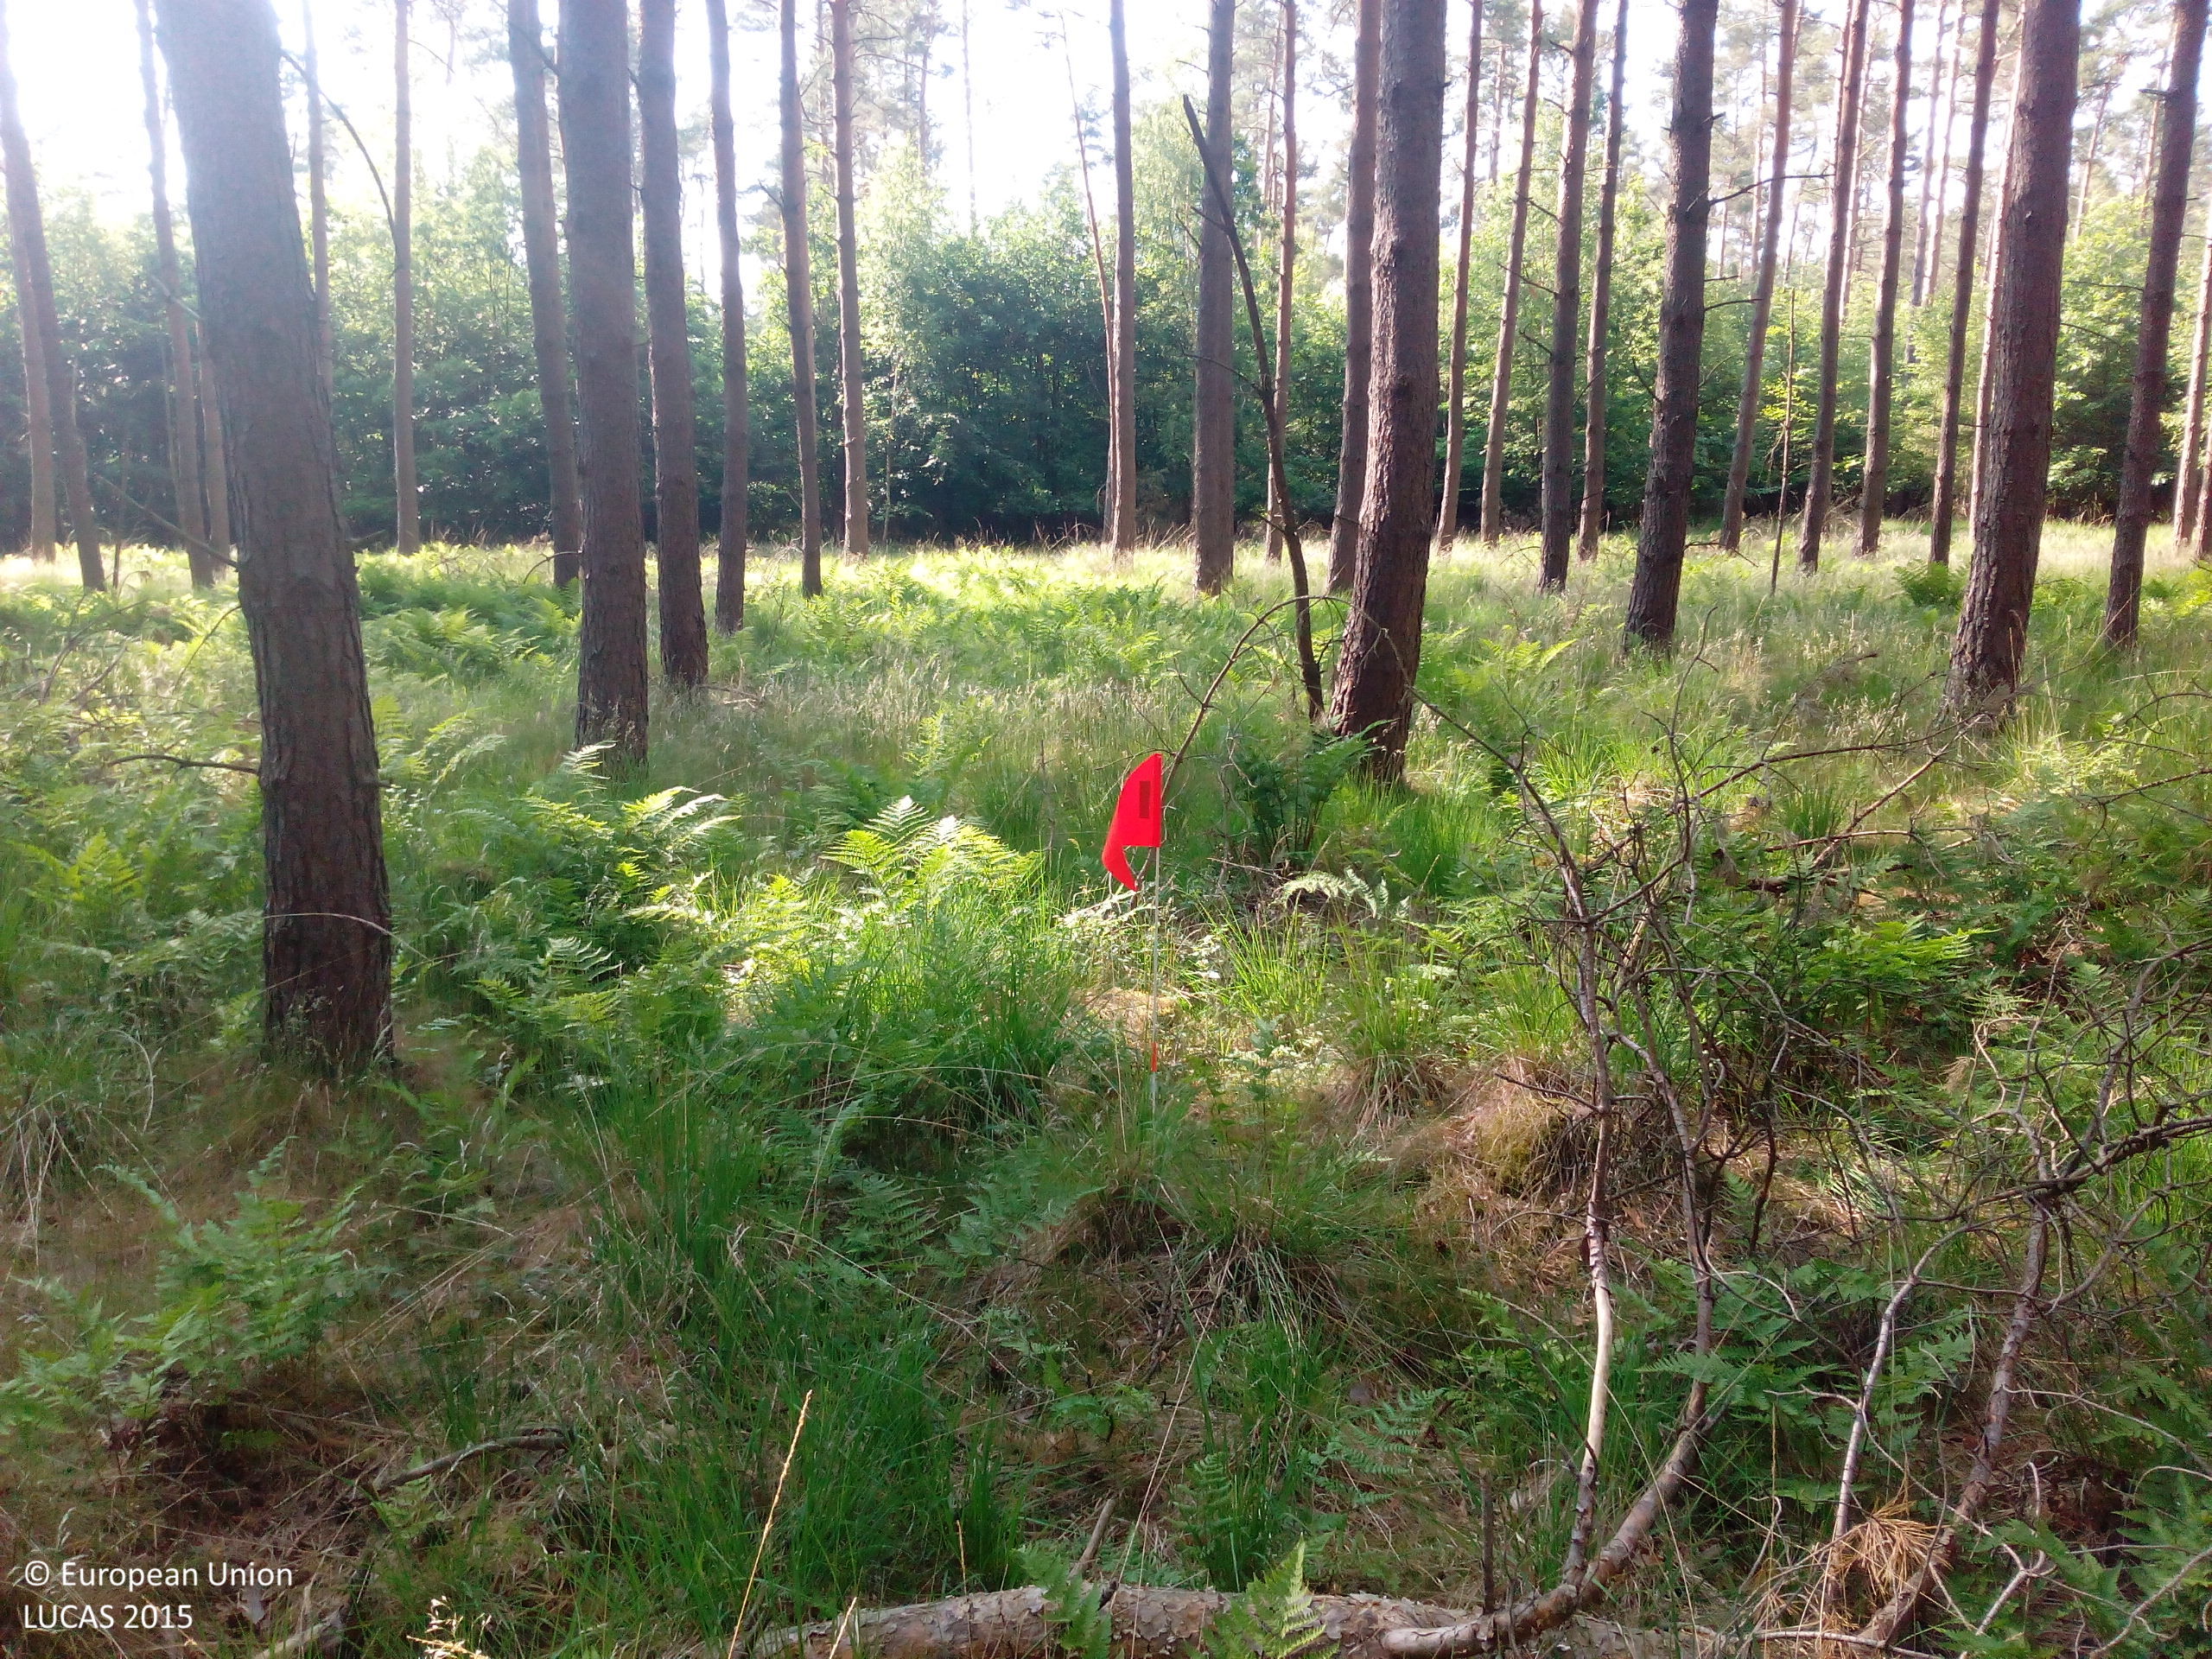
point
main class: Woodland
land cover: Pine dominated coniferous woodland
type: hemiboreal forest and nemoral coniferous forest and mixed broadleaved-coniferous forest
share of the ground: > 75 %
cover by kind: coniferous forest trees 75 %, herbaceous plants 20 %, lichens and mosses 5 %
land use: Forestry
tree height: > 5 m
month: June
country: DE
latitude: 52.5192
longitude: 10.6924
